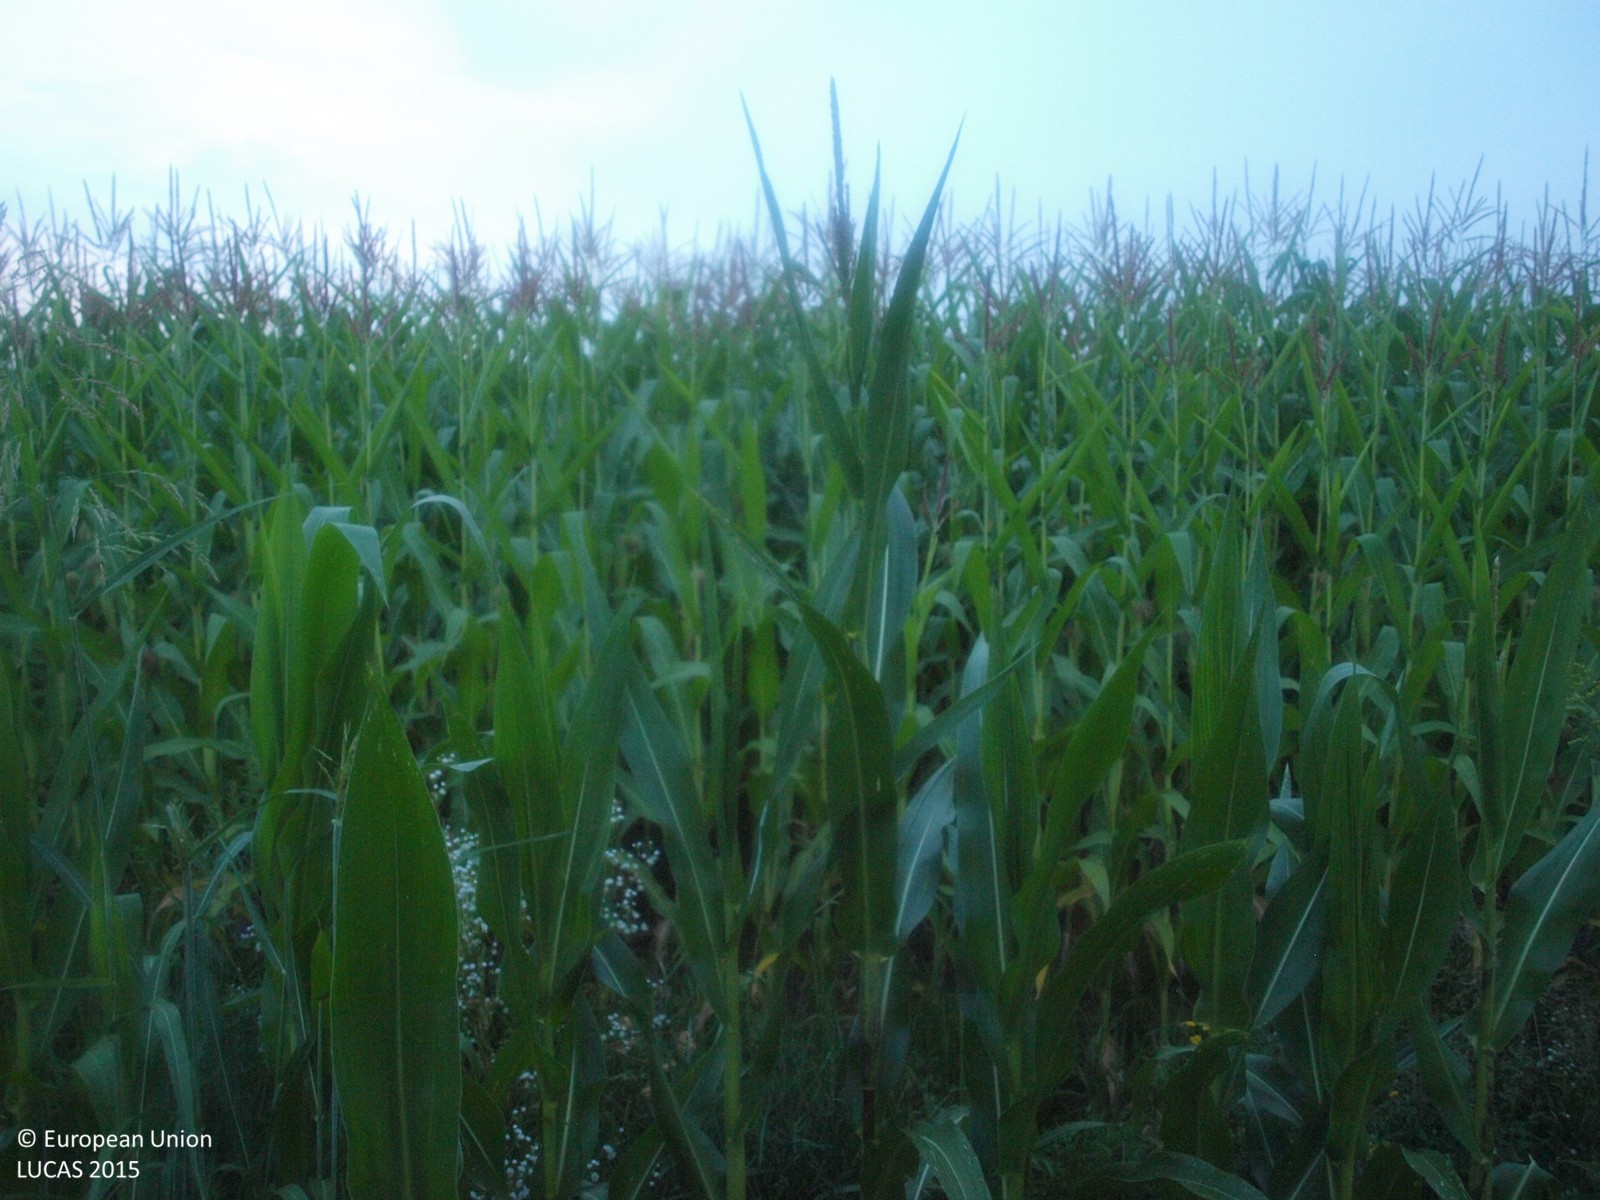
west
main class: Cropland
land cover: Maize
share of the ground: > 75 %
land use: Agriculture (excluding fallow land and kitchen gardens)
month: July
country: HR
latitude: 46.2407
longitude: 16.5498
